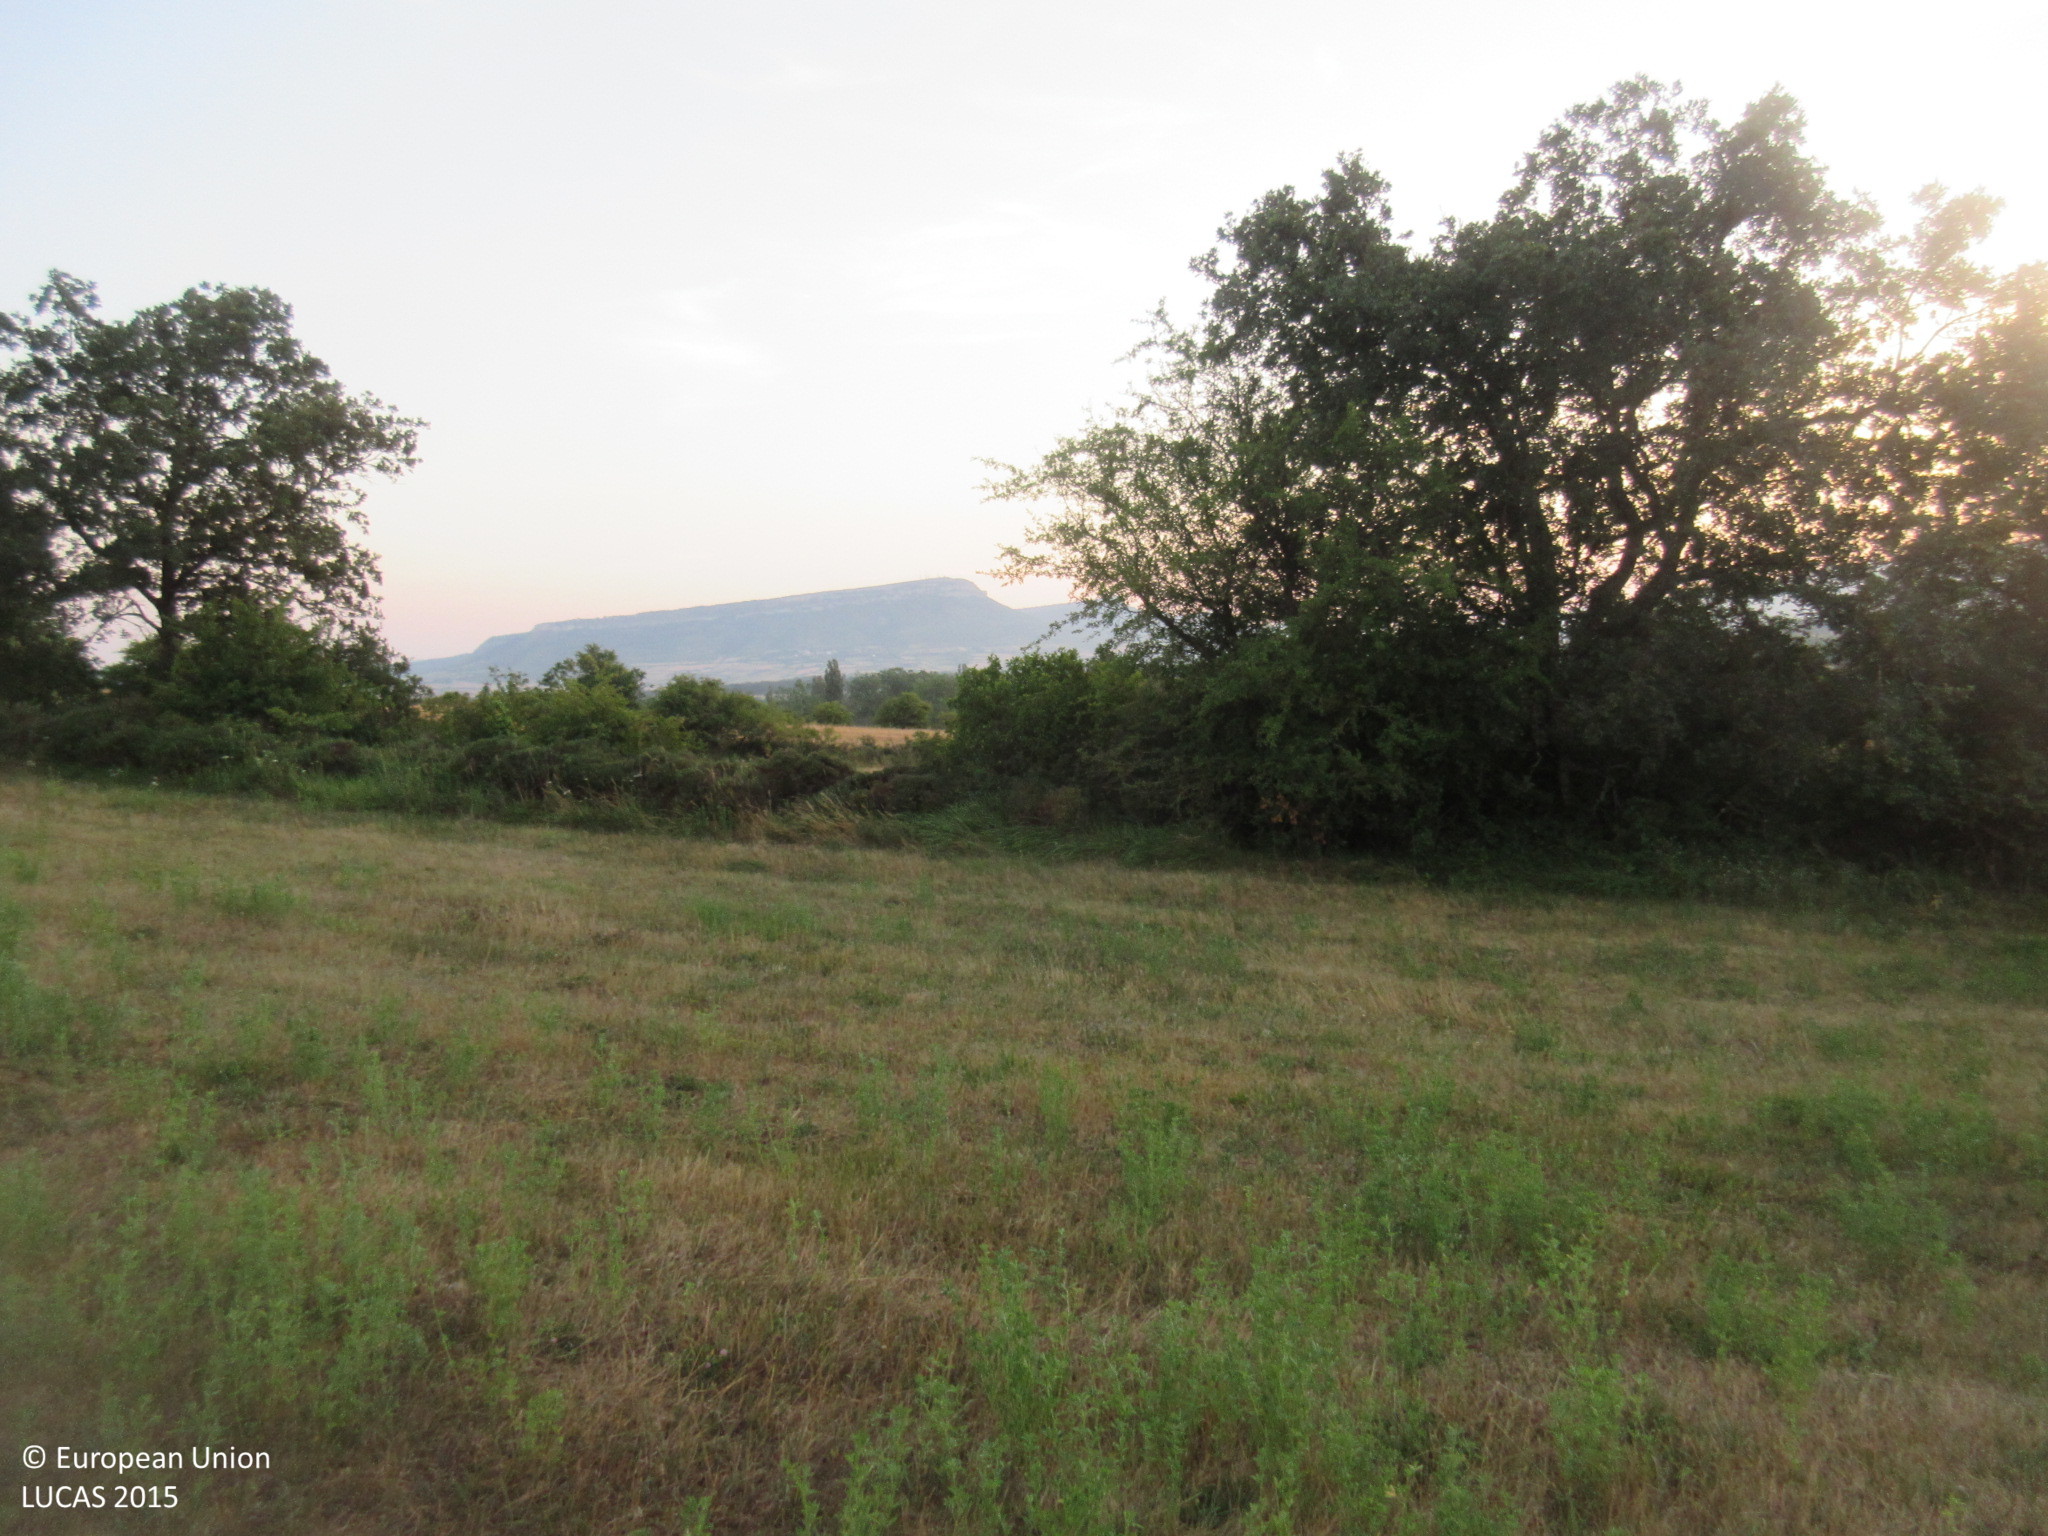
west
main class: Cropland
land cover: Lucerne
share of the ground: 25 - 50 %
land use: Agriculture (excluding fallow land and kitchen gardens)
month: July
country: ES
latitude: 43.0668
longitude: -3.4620
